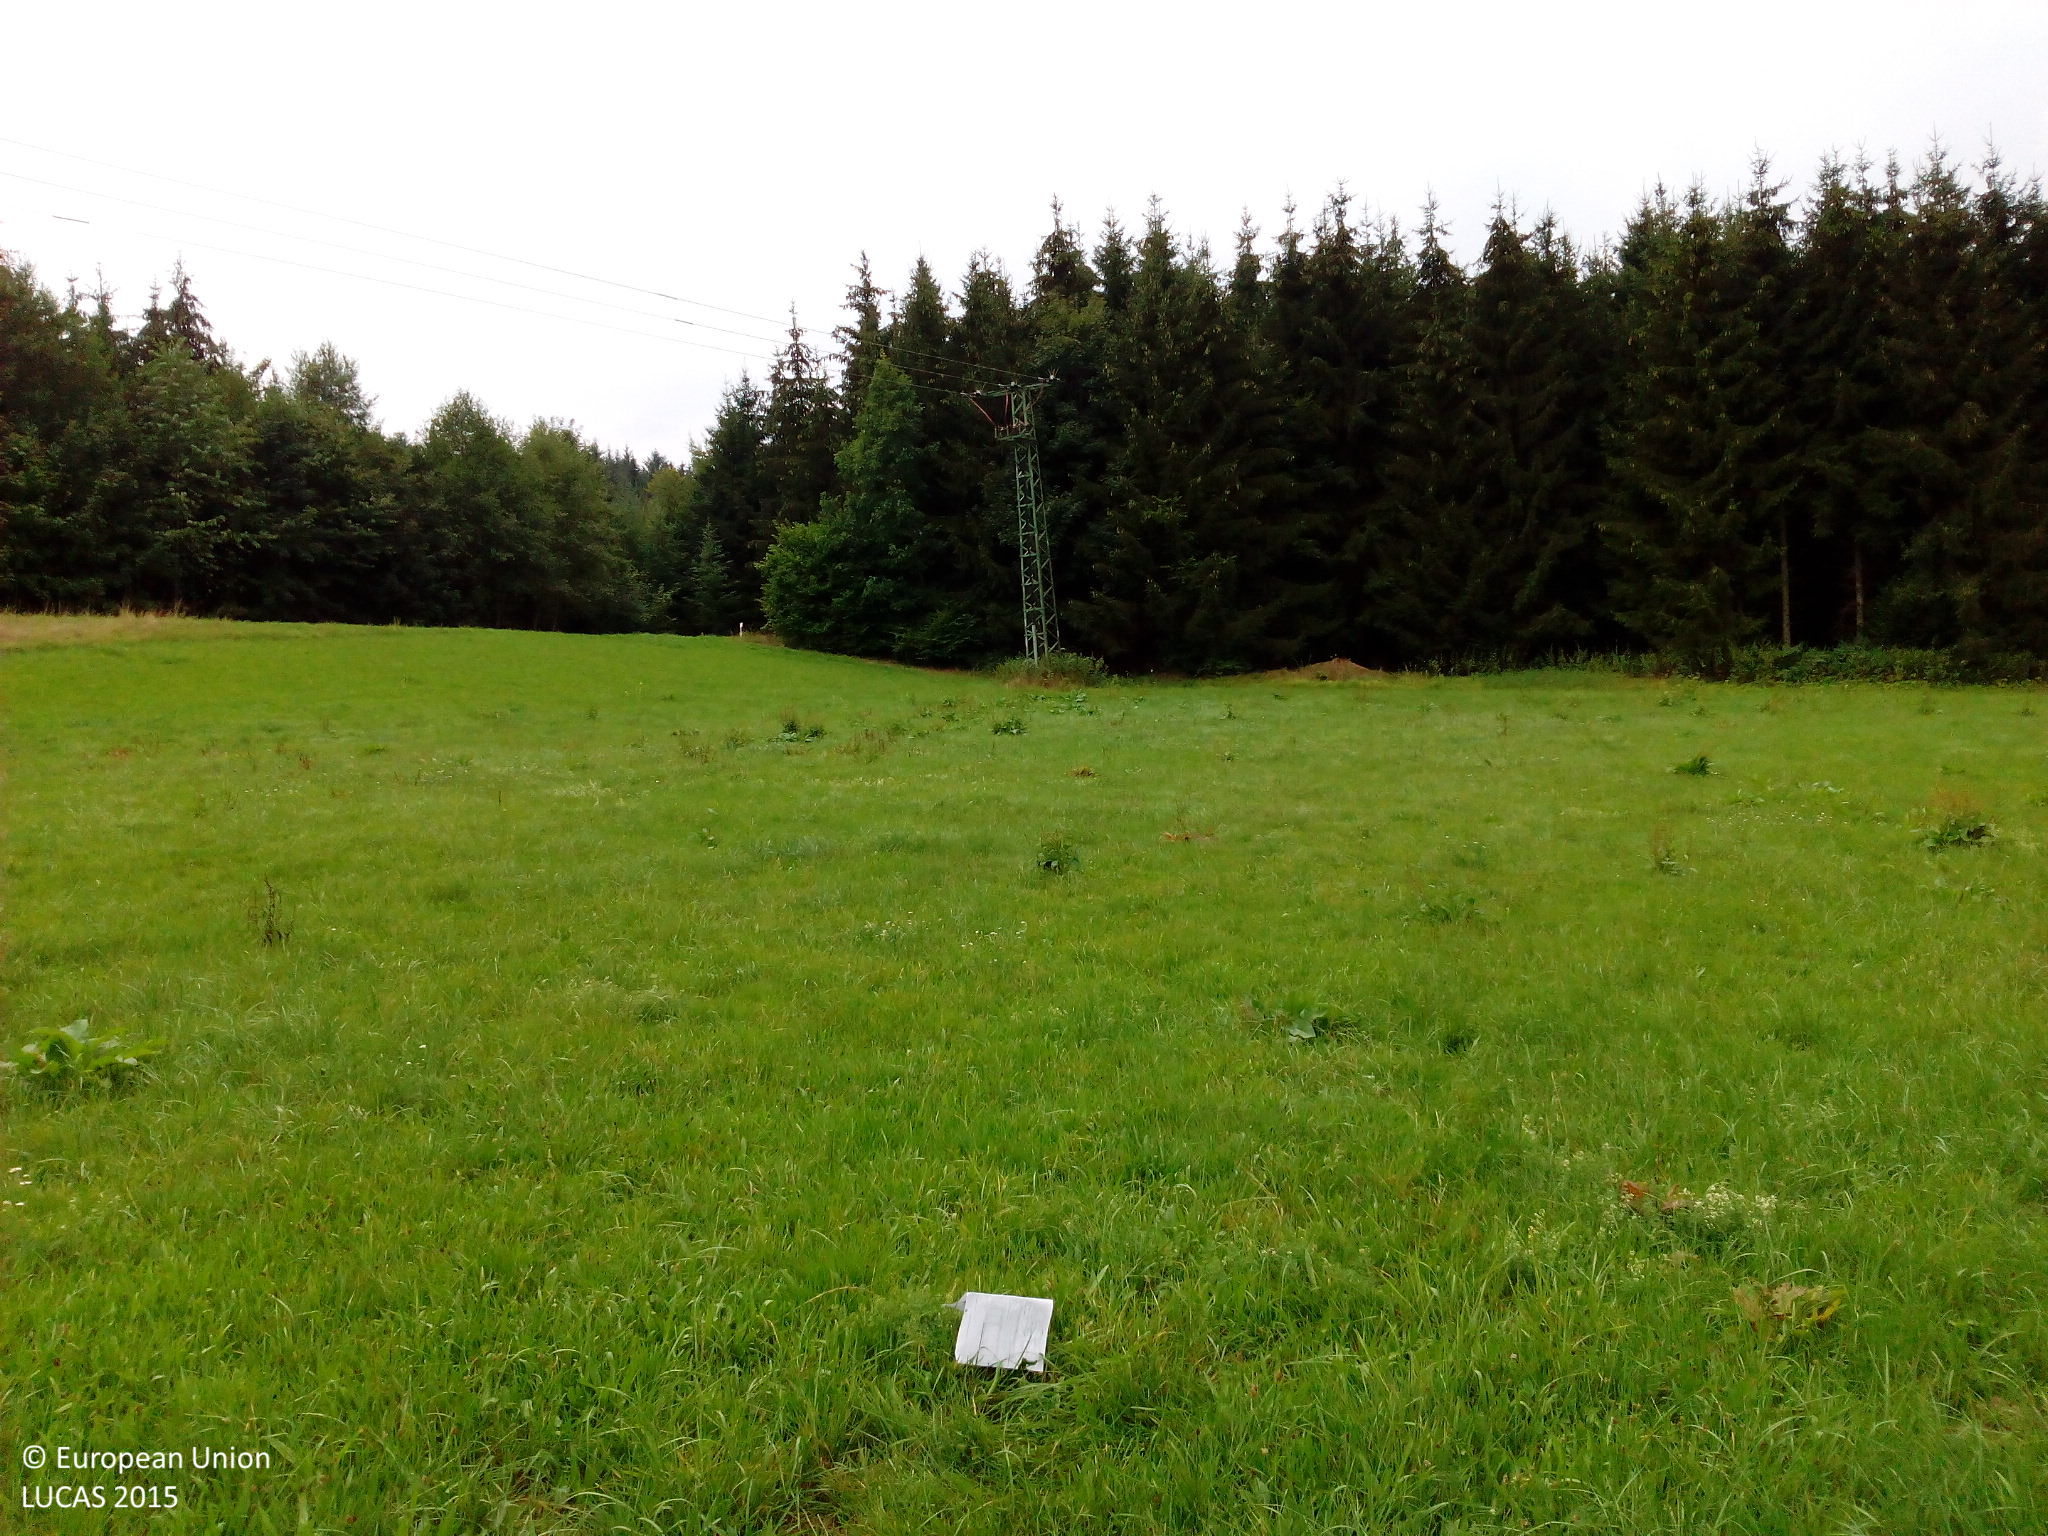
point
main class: Grassland
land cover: Grassland without tree/shrub cover
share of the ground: > 75 %
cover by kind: herbaceous plants 100 %
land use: Agriculture (excluding fallow land and kitchen gardens)
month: September
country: DE
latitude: 48.3482
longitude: 10.5259
